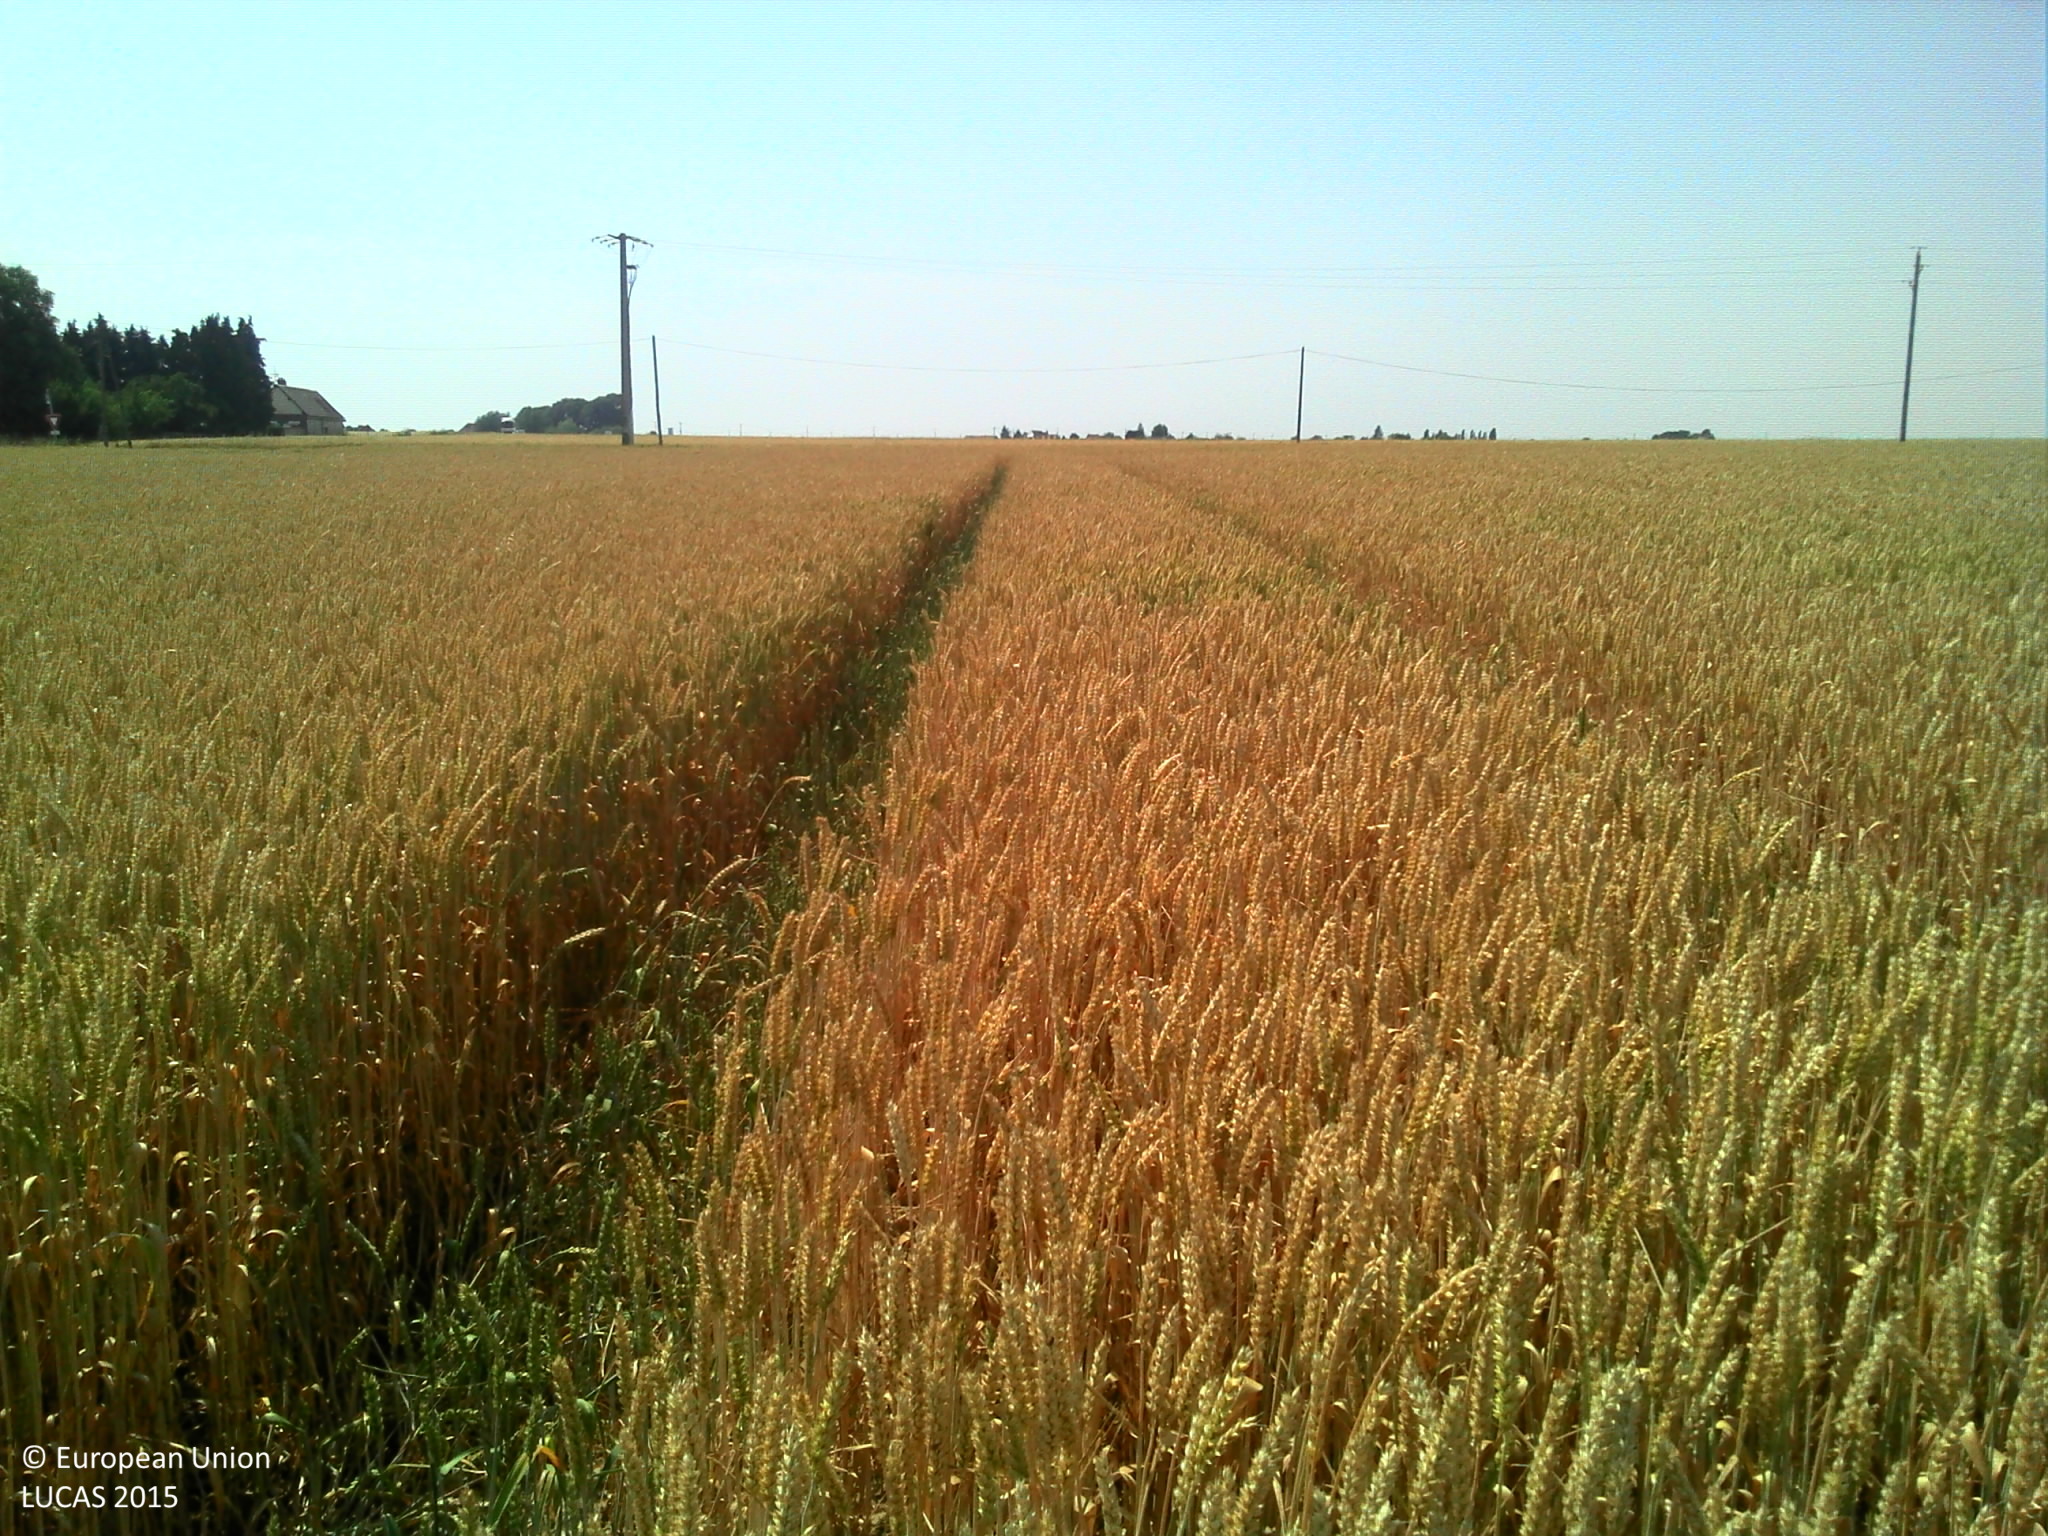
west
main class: Cropland
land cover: Common wheat
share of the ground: > 75 %
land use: Agriculture (excluding fallow land and kitchen gardens)
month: July
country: FR
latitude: 48.9118
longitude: 1.3166
